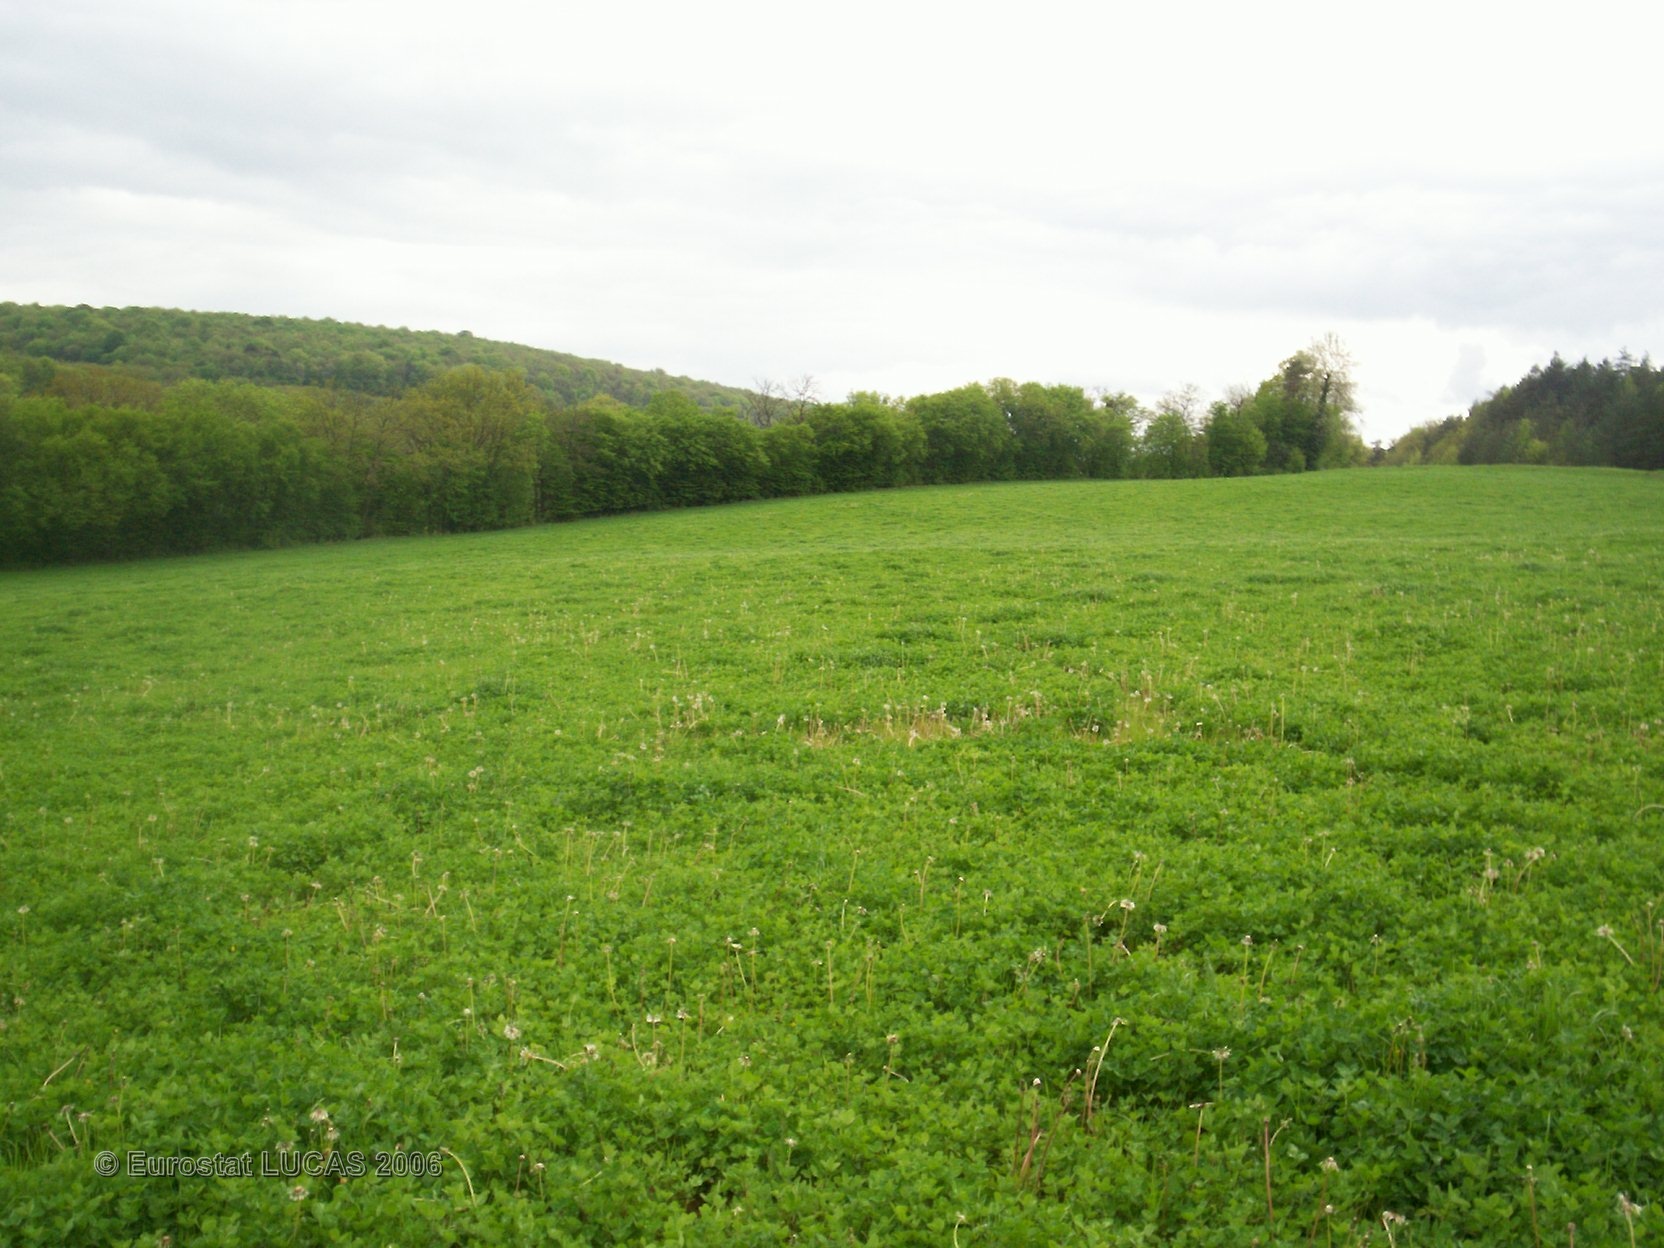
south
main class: Cropland
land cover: Clovers
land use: Agriculture (excluding fallow land and kitchen gardens)
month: May
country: FR
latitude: 47.7304
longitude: 4.5988
